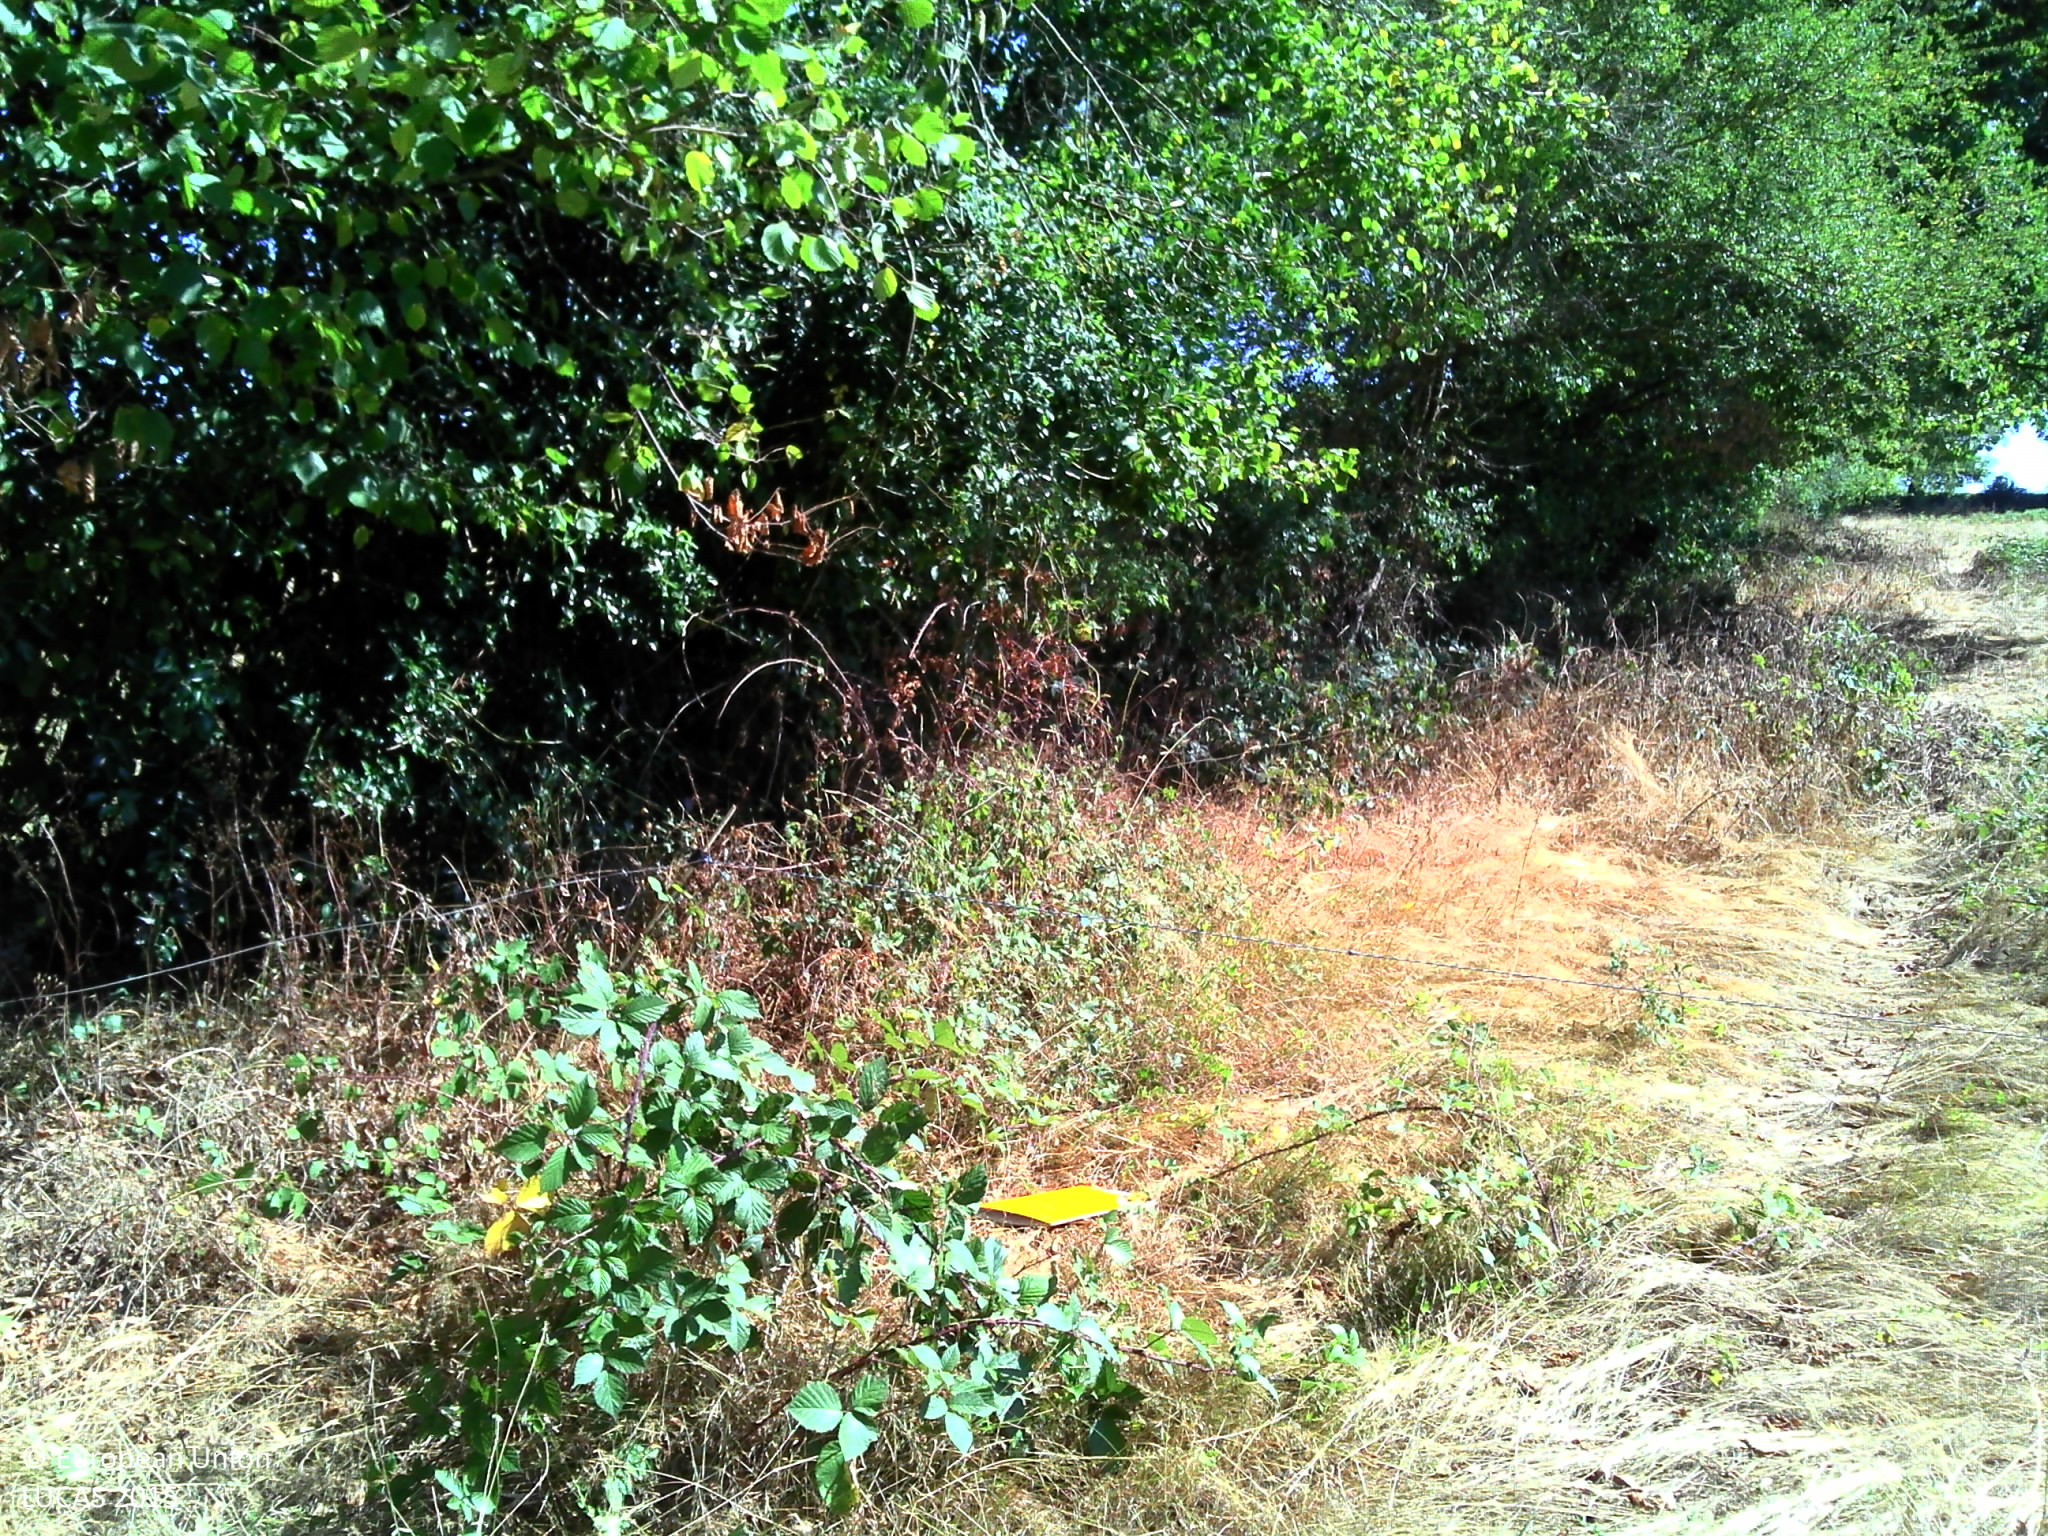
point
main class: Grassland
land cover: Grassland without tree/shrub cover
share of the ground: > 75 %
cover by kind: herbaceous plants 95 %, shrubs 5 %
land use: Agriculture (excluding fallow land and kitchen gardens)
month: August
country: FR
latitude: 46.5950
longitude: 2.7777
